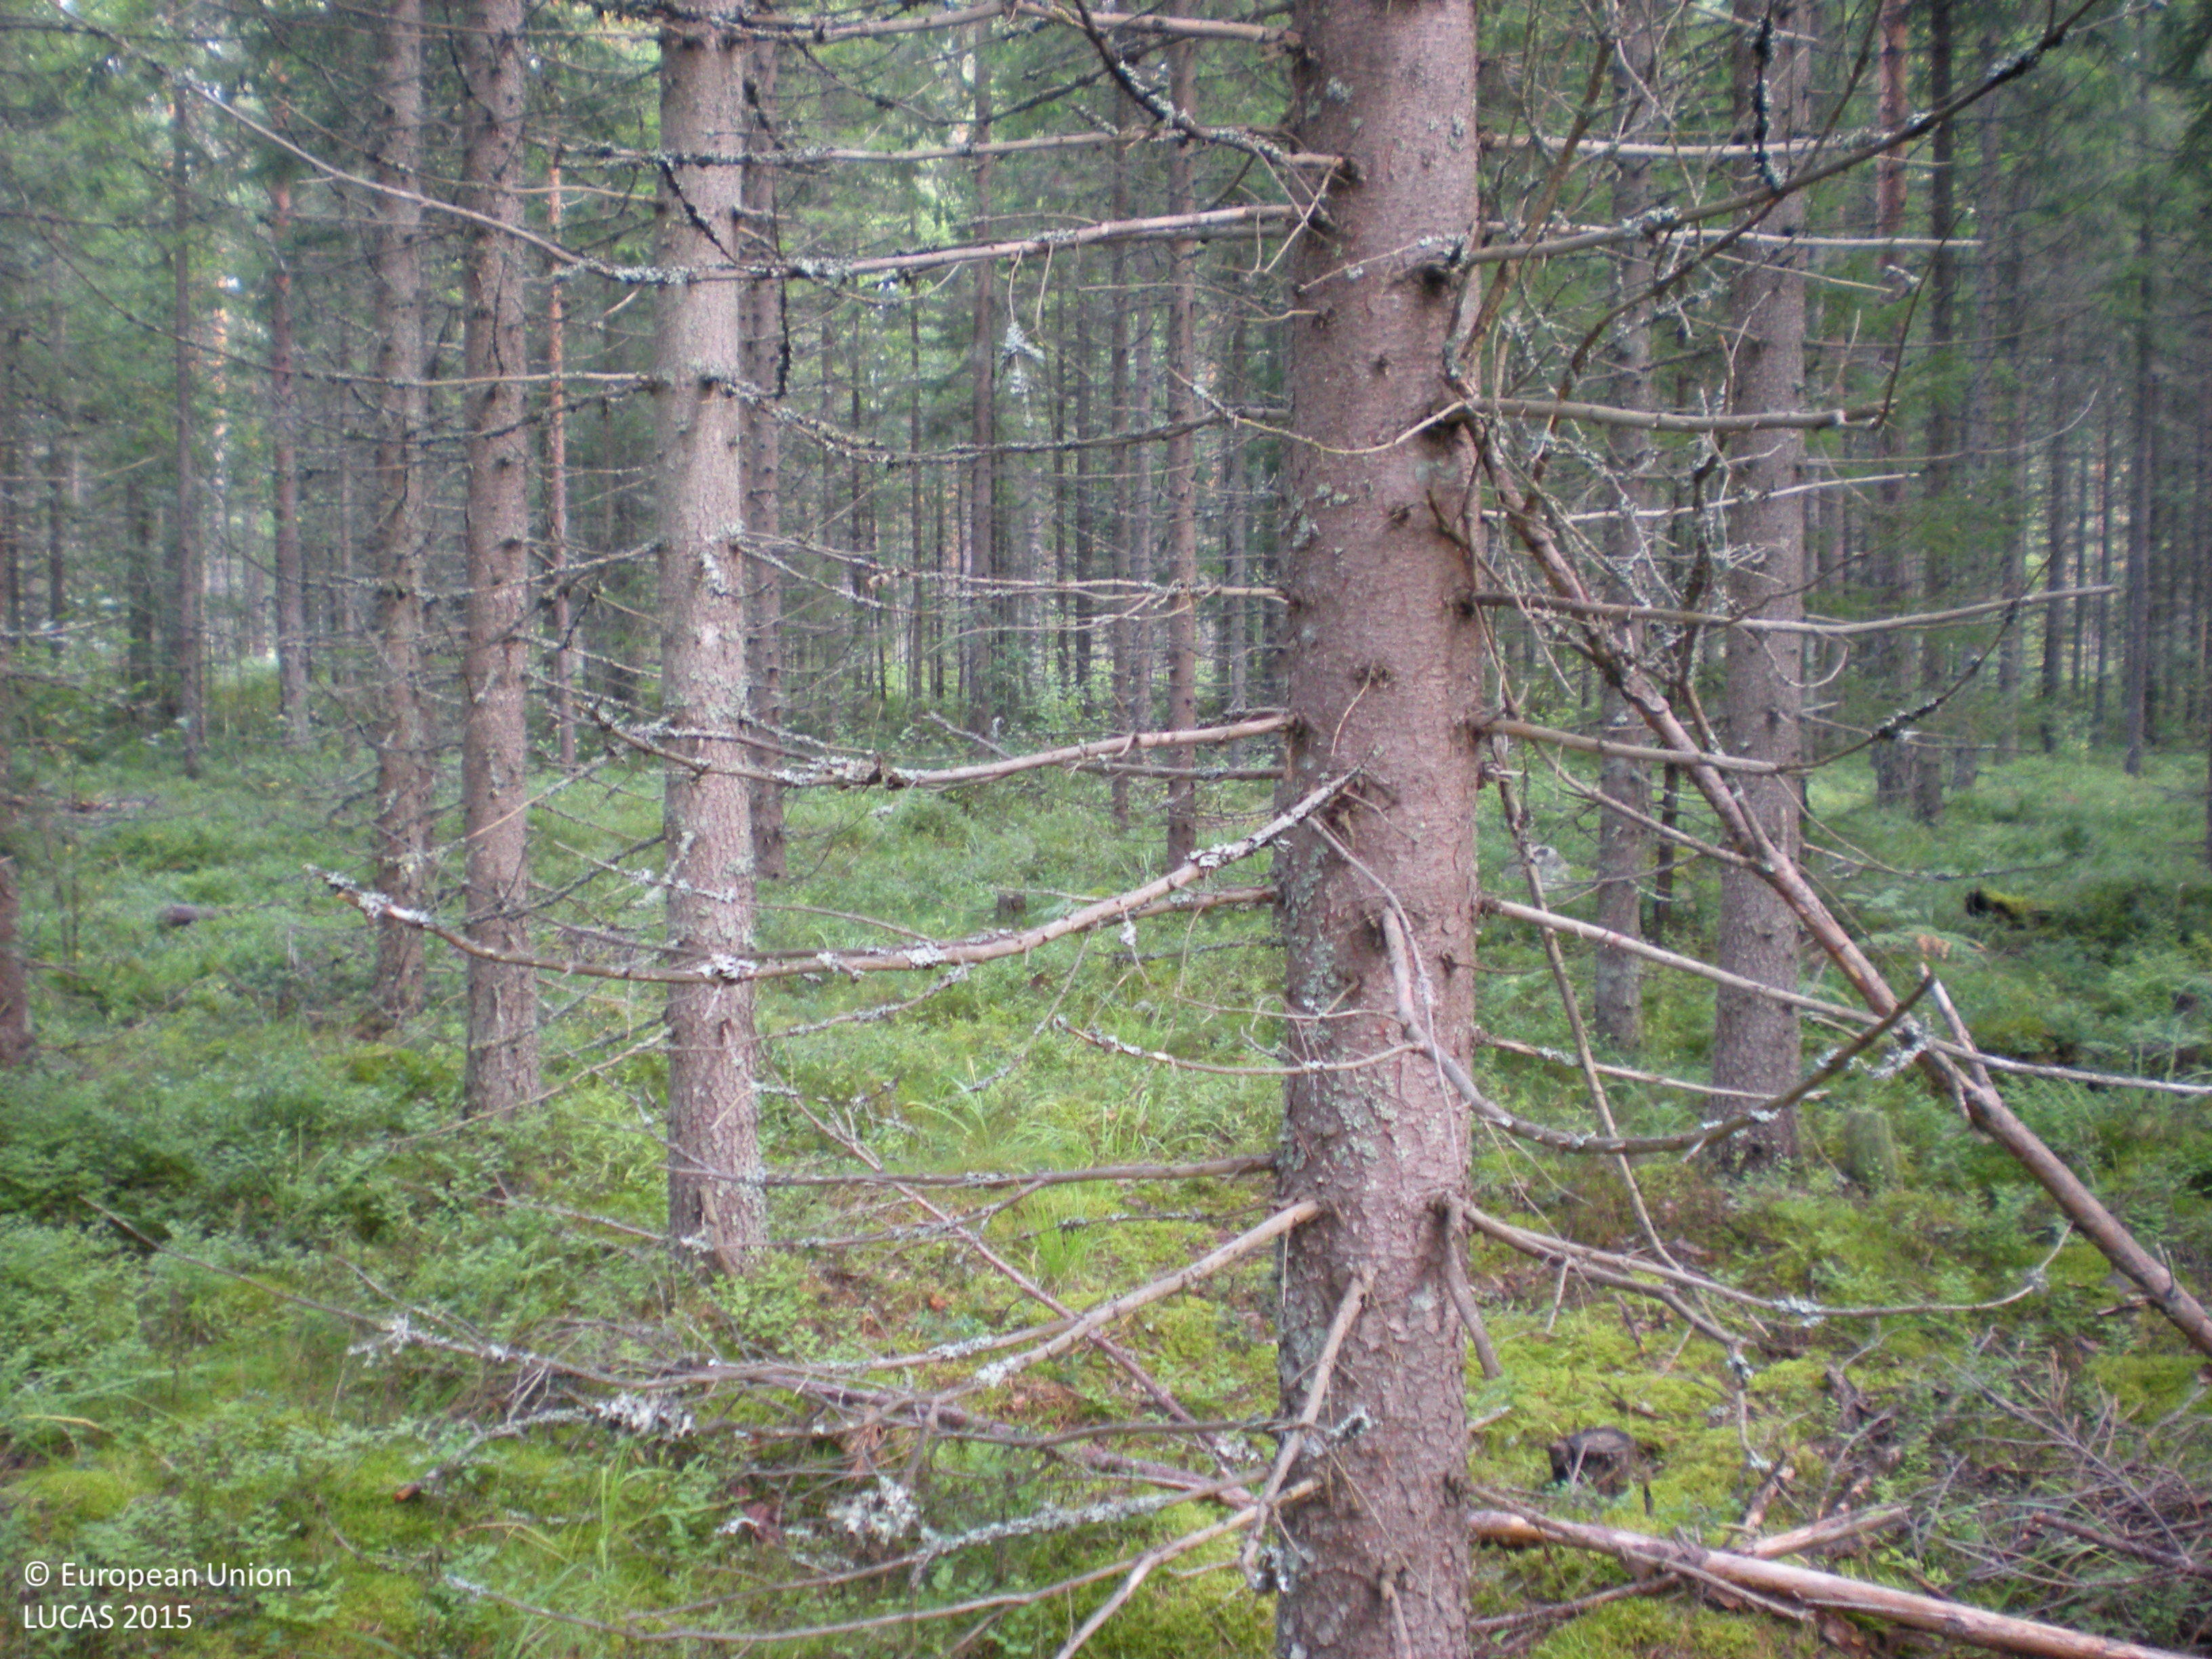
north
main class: Woodland
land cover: Other coniferous woodland
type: boreal forest
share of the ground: > 75 %
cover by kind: coniferous forest trees 75 %, shrubs 15 %, herbaceous plants 5 %, lichens and mosses 5 %
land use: Forestry
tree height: > 5 m
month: August
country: SE
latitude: 60.4898
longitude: 17.1059
